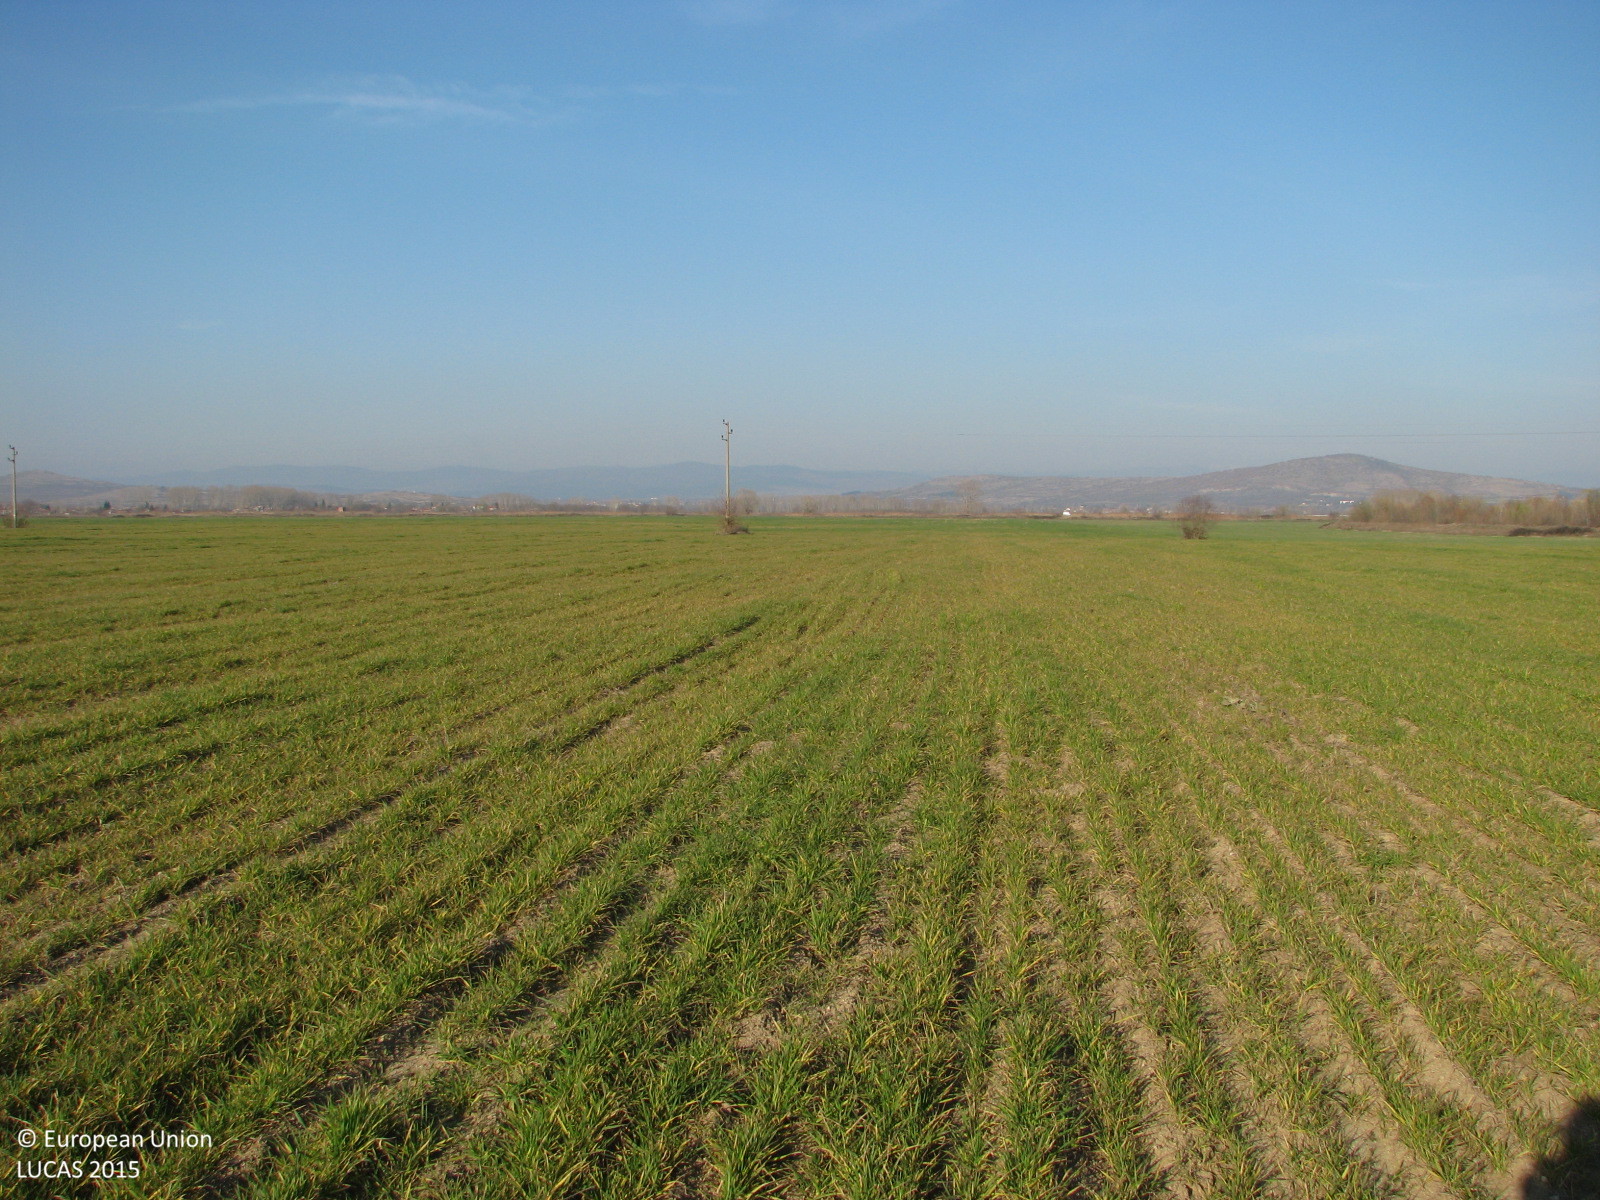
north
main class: Cropland
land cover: Common wheat
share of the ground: > 75 %
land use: Agriculture (excluding fallow land and kitchen gardens)
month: December
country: BG
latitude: 42.2005
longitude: 24.1756
